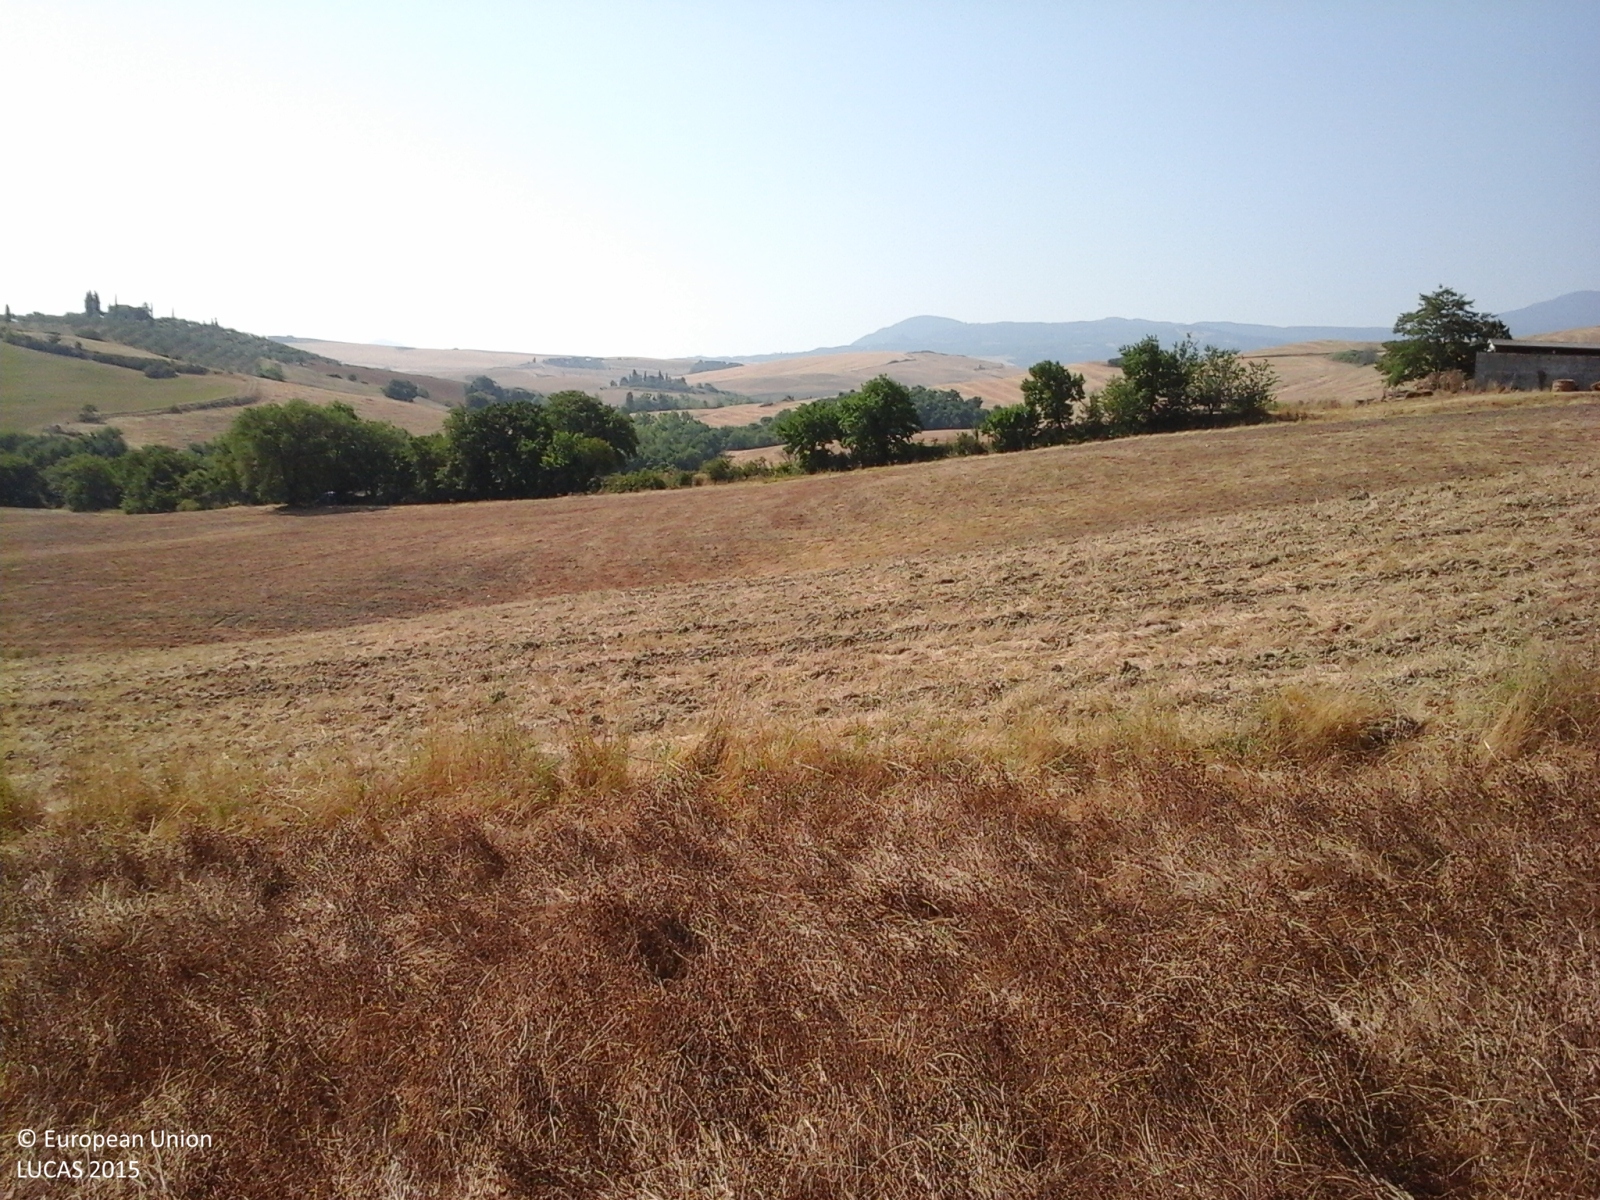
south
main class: Cropland
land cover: Temporary grasslands
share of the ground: > 75 %
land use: Agriculture (excluding fallow land and kitchen gardens)
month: July
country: IT
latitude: 43.0202
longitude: 11.6270
